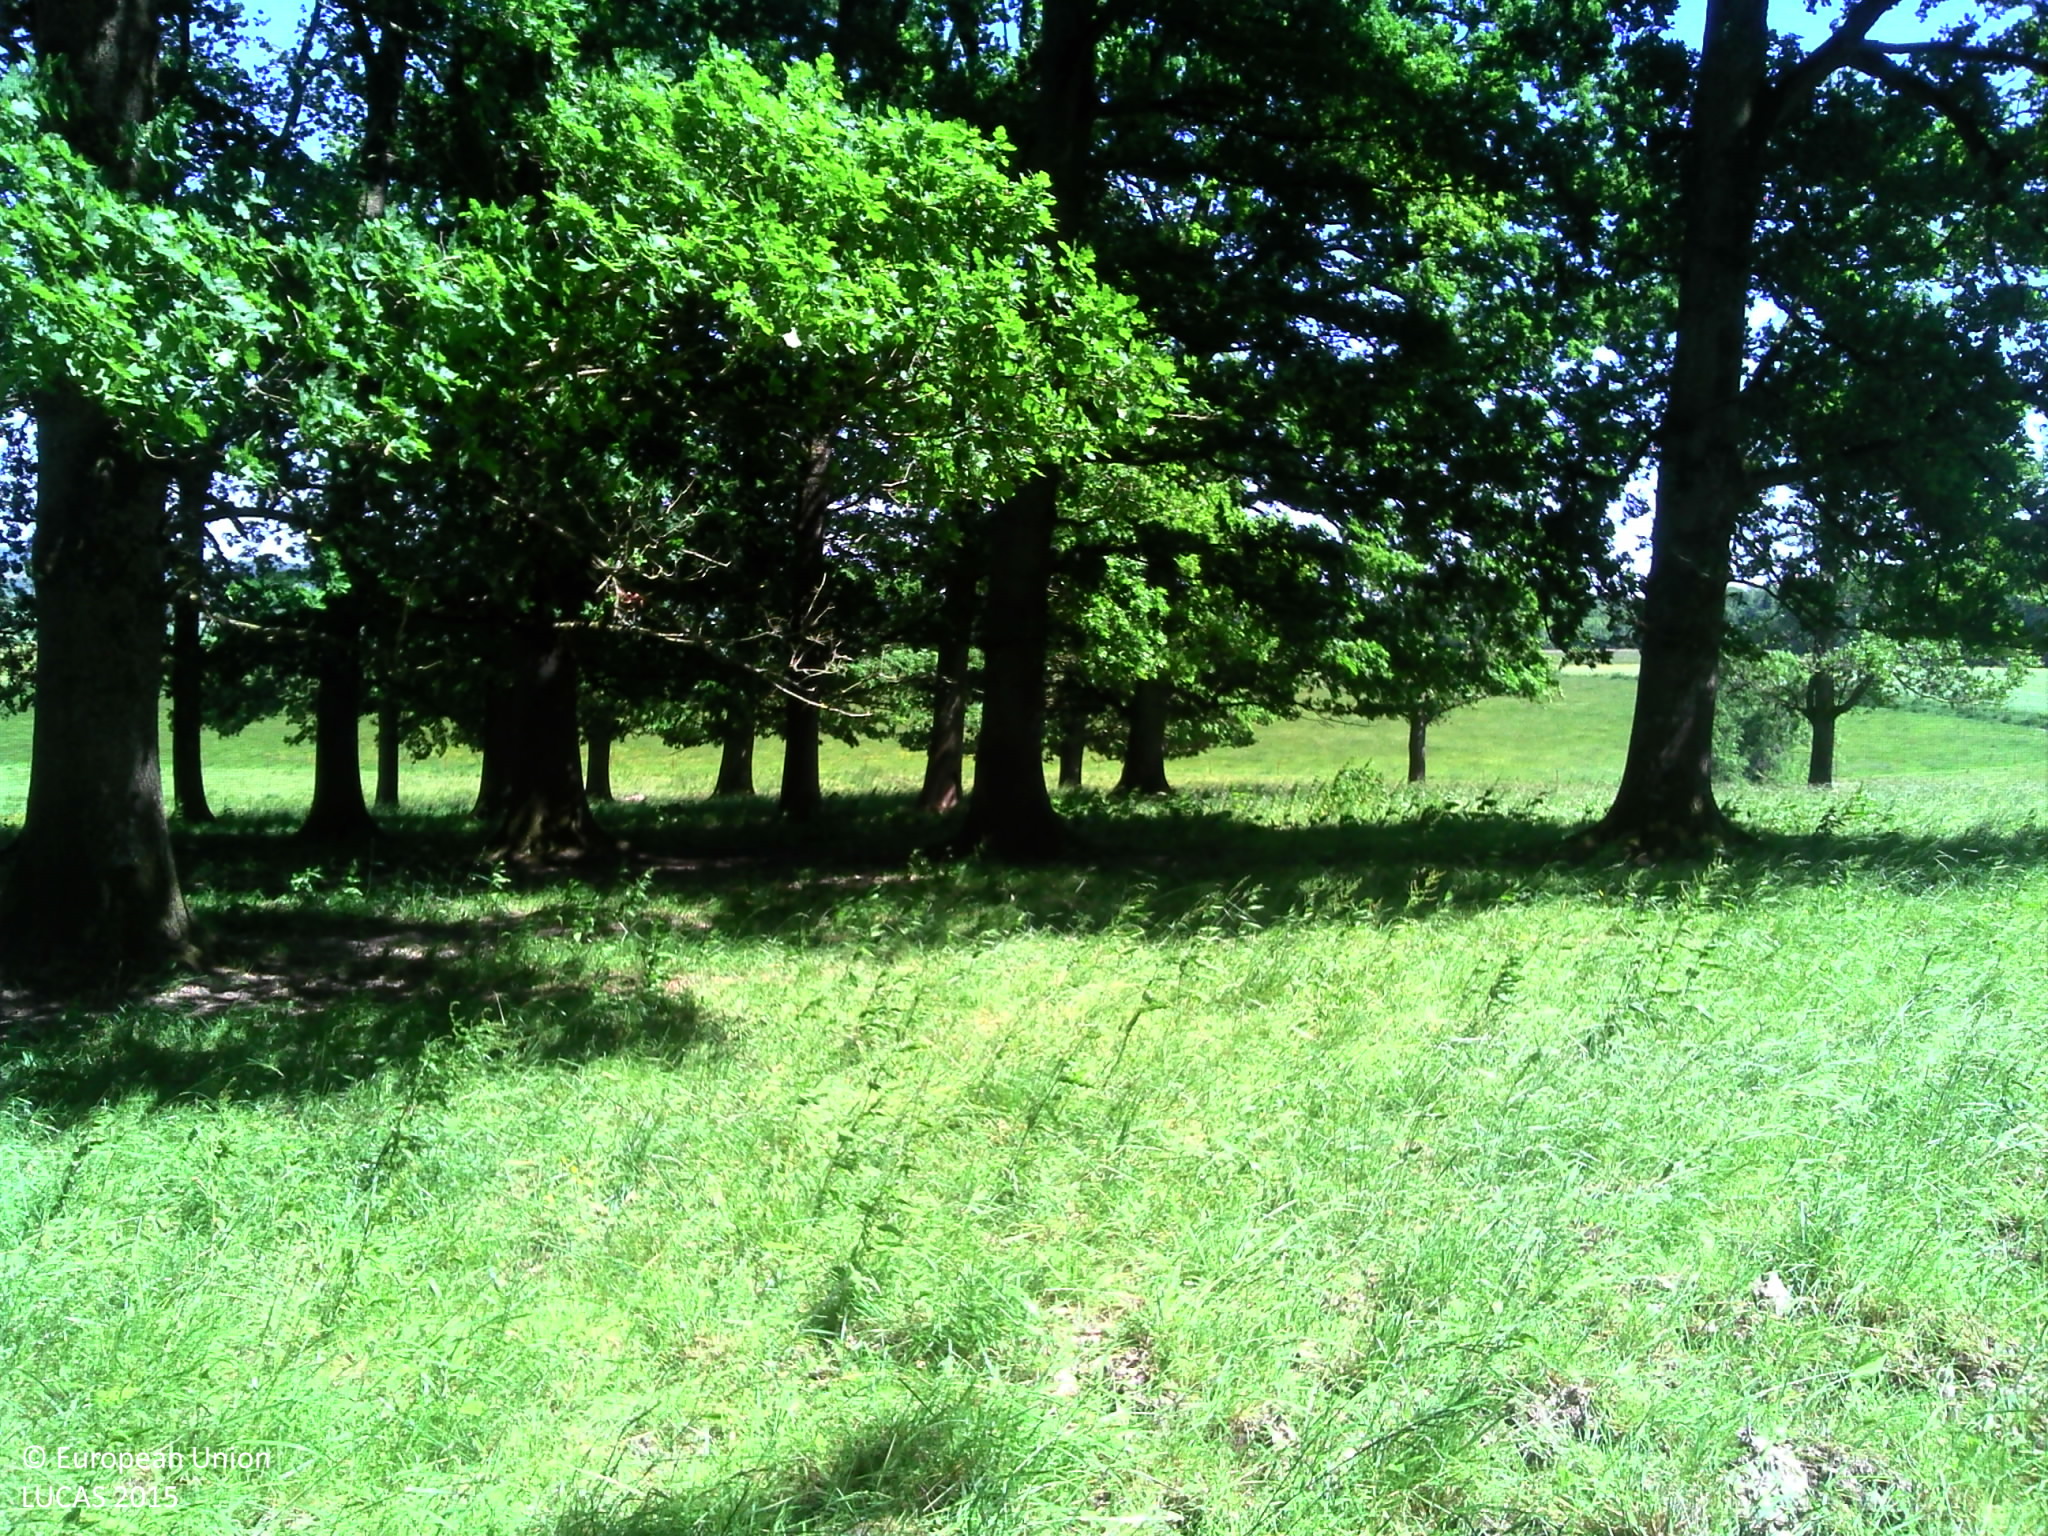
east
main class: Grassland
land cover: Grassland without tree/shrub cover
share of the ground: > 75 %
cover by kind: herbaceous plants 100 %
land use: Agriculture (excluding fallow land and kitchen gardens)
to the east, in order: Grassland without tree/shrub cover; Broadleaved woodland; Grassland without tree/shrub cover; Fences; Grassland without tree/shrub cover
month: June
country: FR
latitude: 49.8367
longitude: 4.1693
